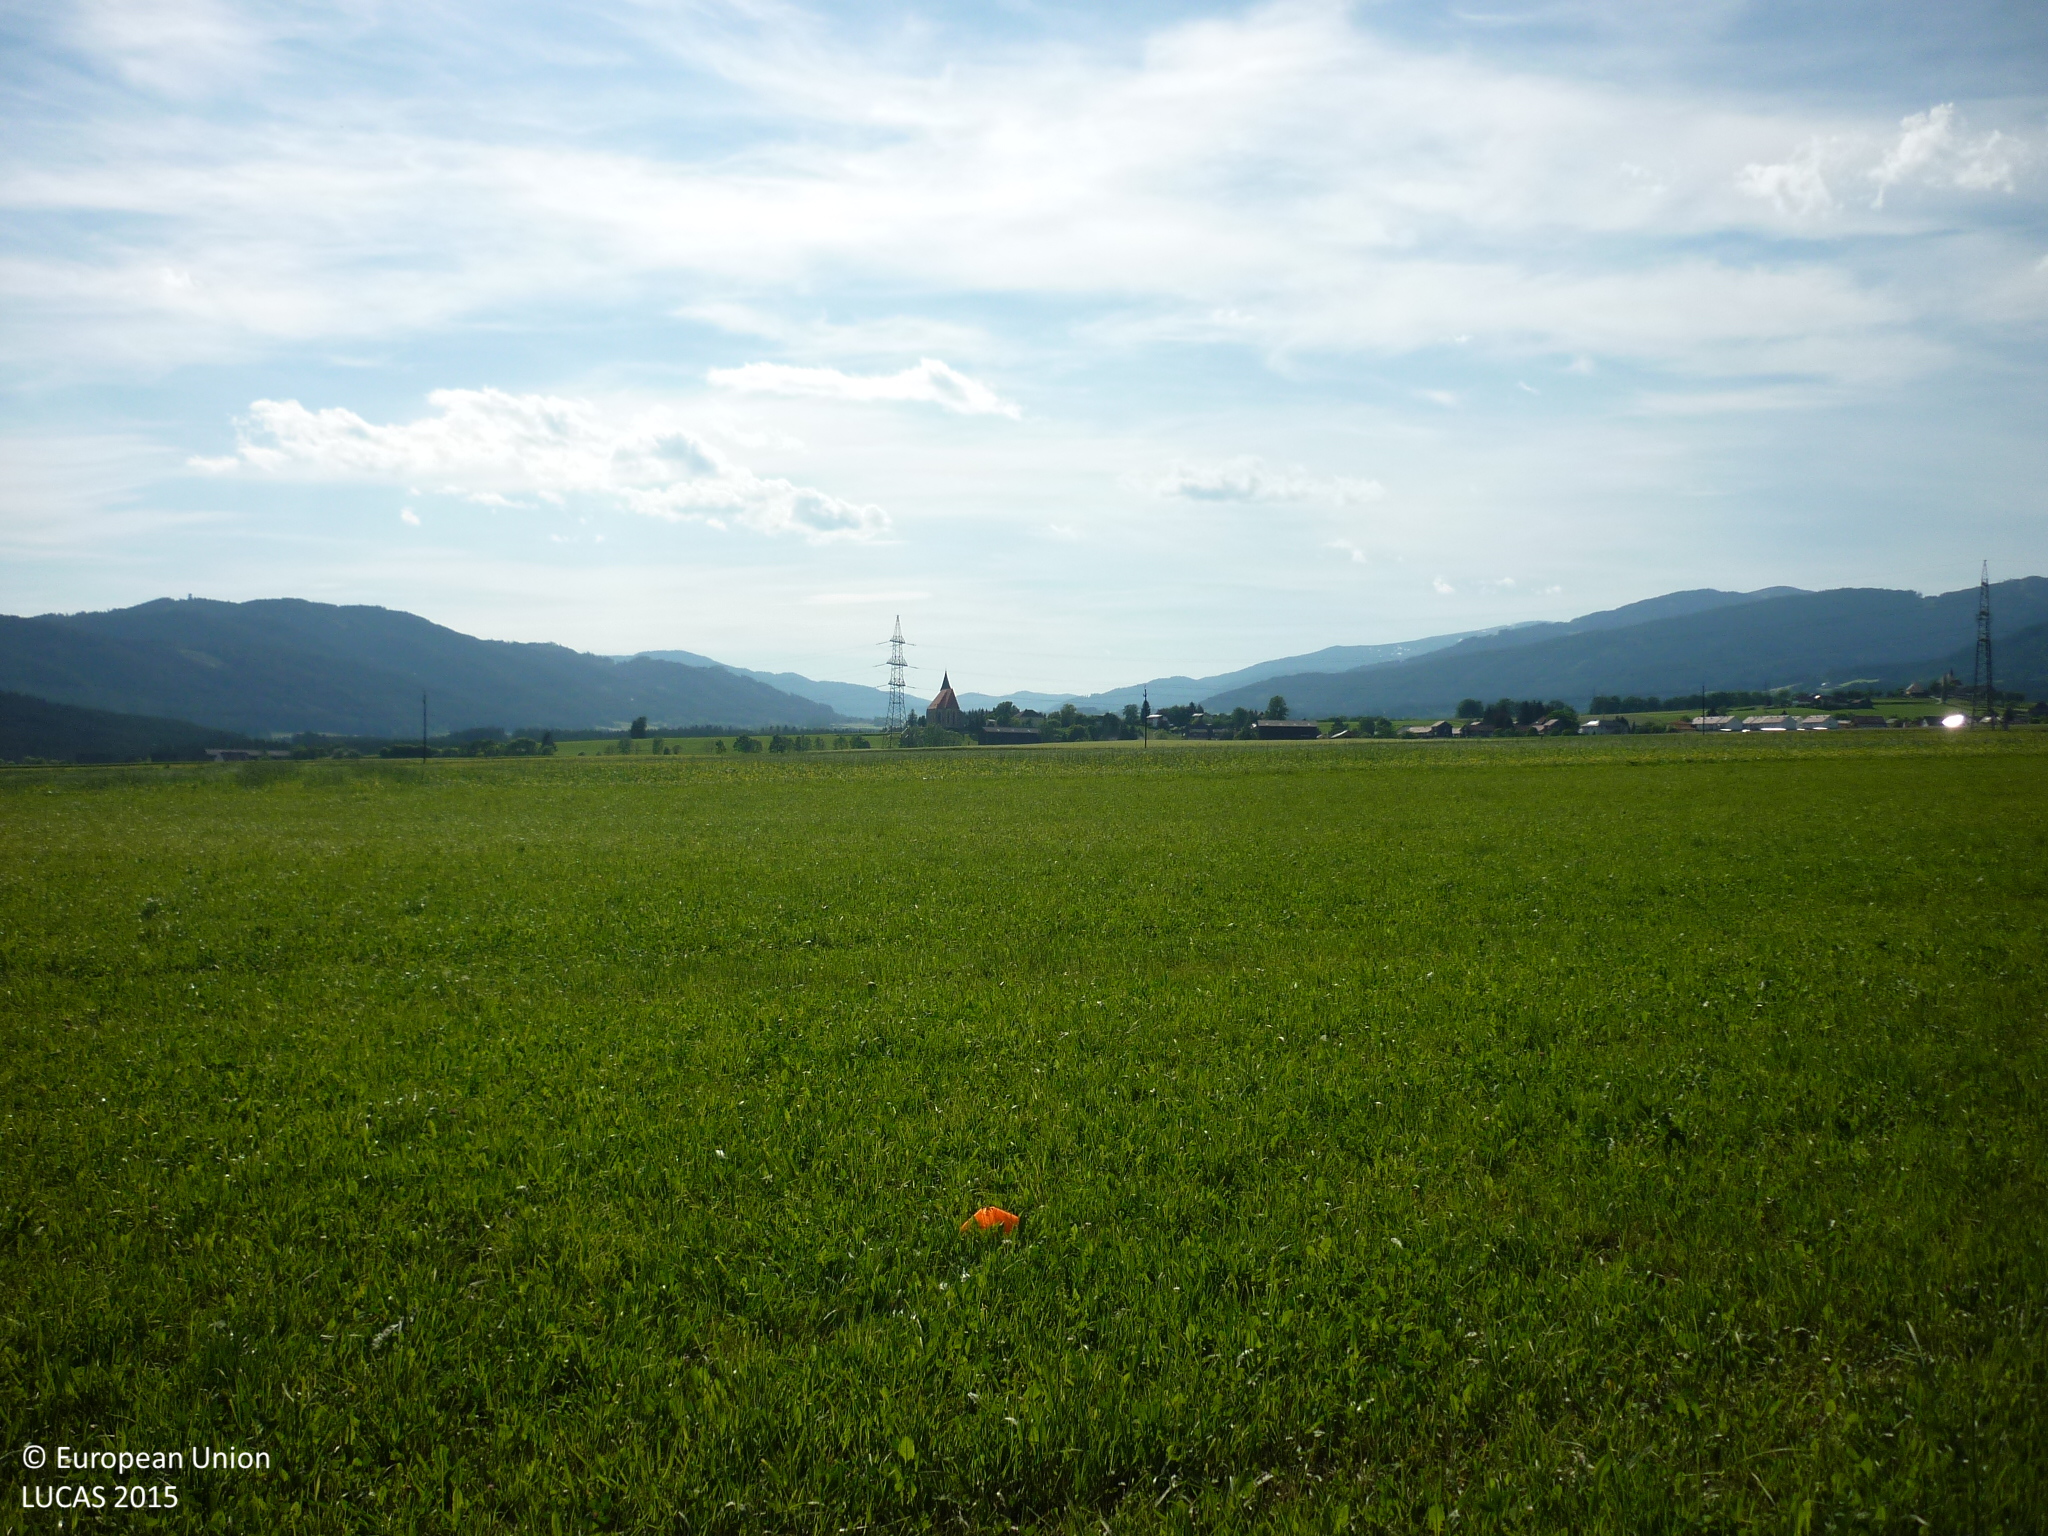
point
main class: Grassland
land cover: Grassland without tree/shrub cover
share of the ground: > 75 %
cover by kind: herbaceous plants 100 %
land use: Agriculture (excluding fallow land and kitchen gardens)
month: May
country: AT
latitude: 47.2682
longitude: 14.8765
